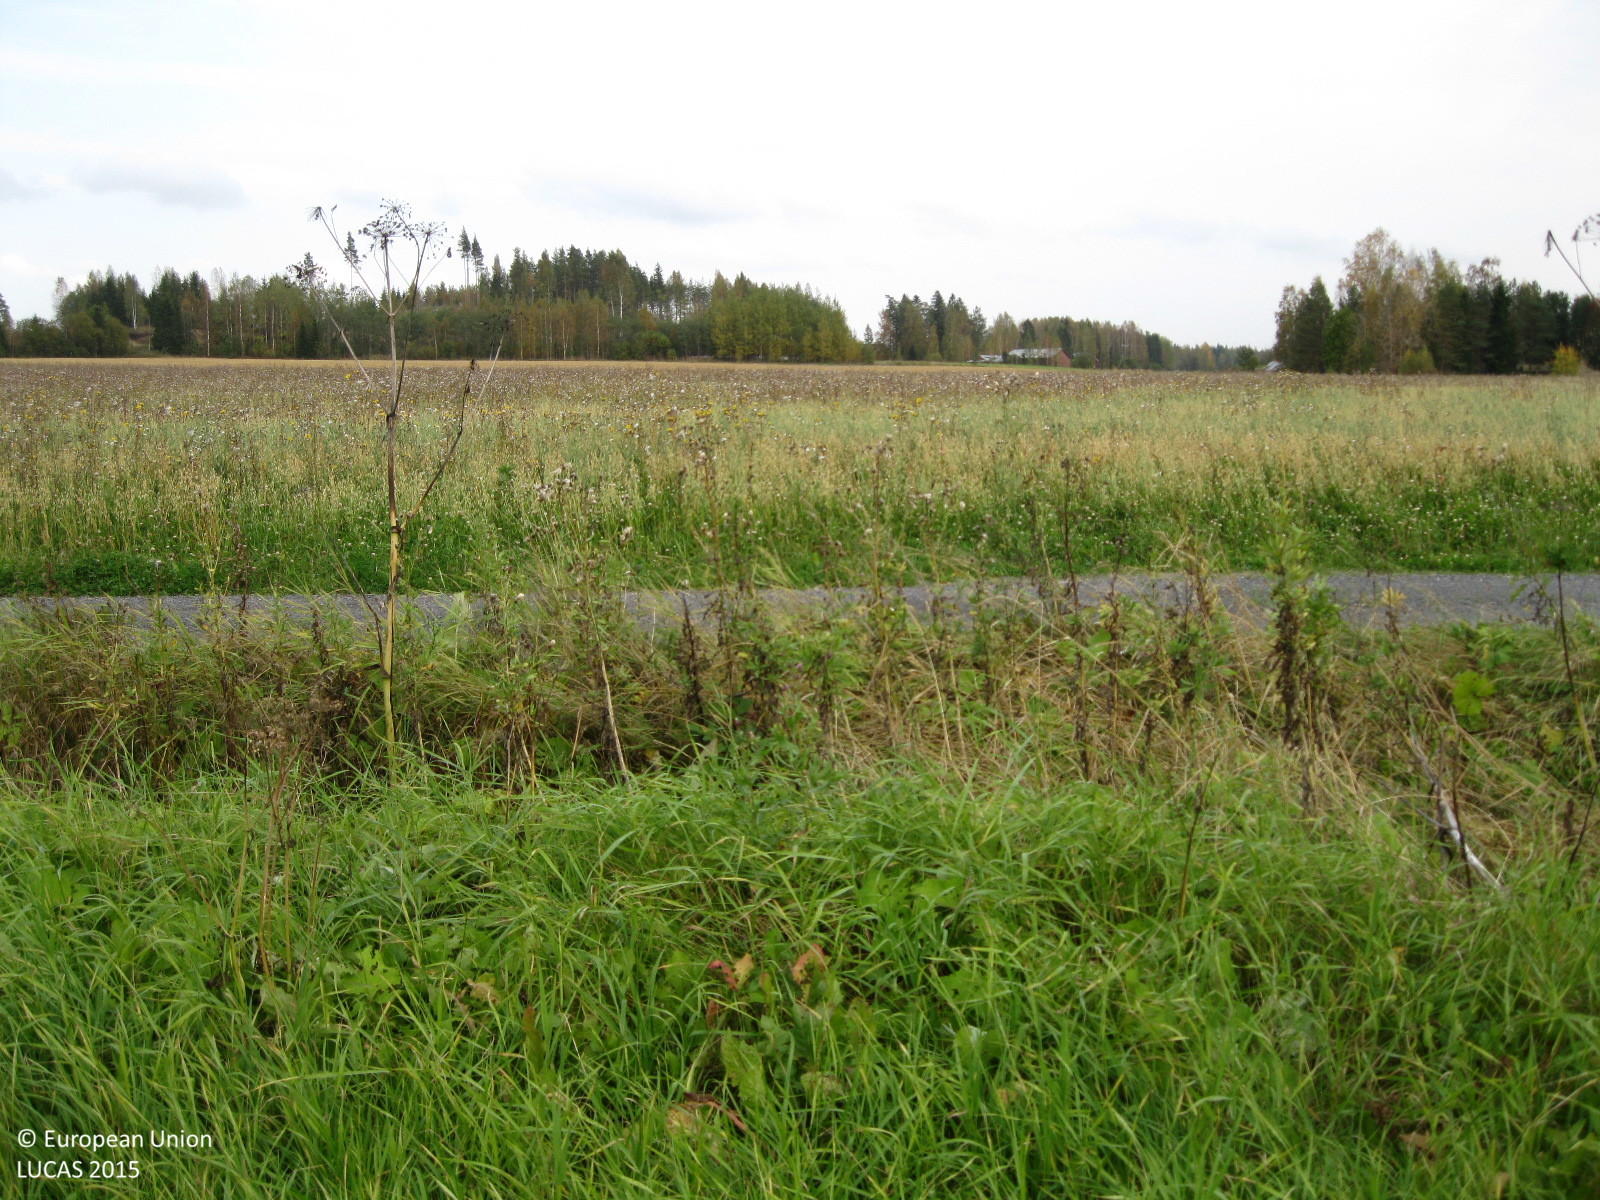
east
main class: Cropland
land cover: Temporary grasslands
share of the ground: > 75 %
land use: Agriculture (excluding fallow land and kitchen gardens)
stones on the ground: < 10 %
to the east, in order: Temporary grasslands; Grass margins; Electric lines; Ditches and canals; Grass margins; Tracks; Grass margins; Oats; Grass margins; Ditches and canals; Grass margins; Barley
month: September
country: FI
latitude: 60.5842
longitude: 24.6566
